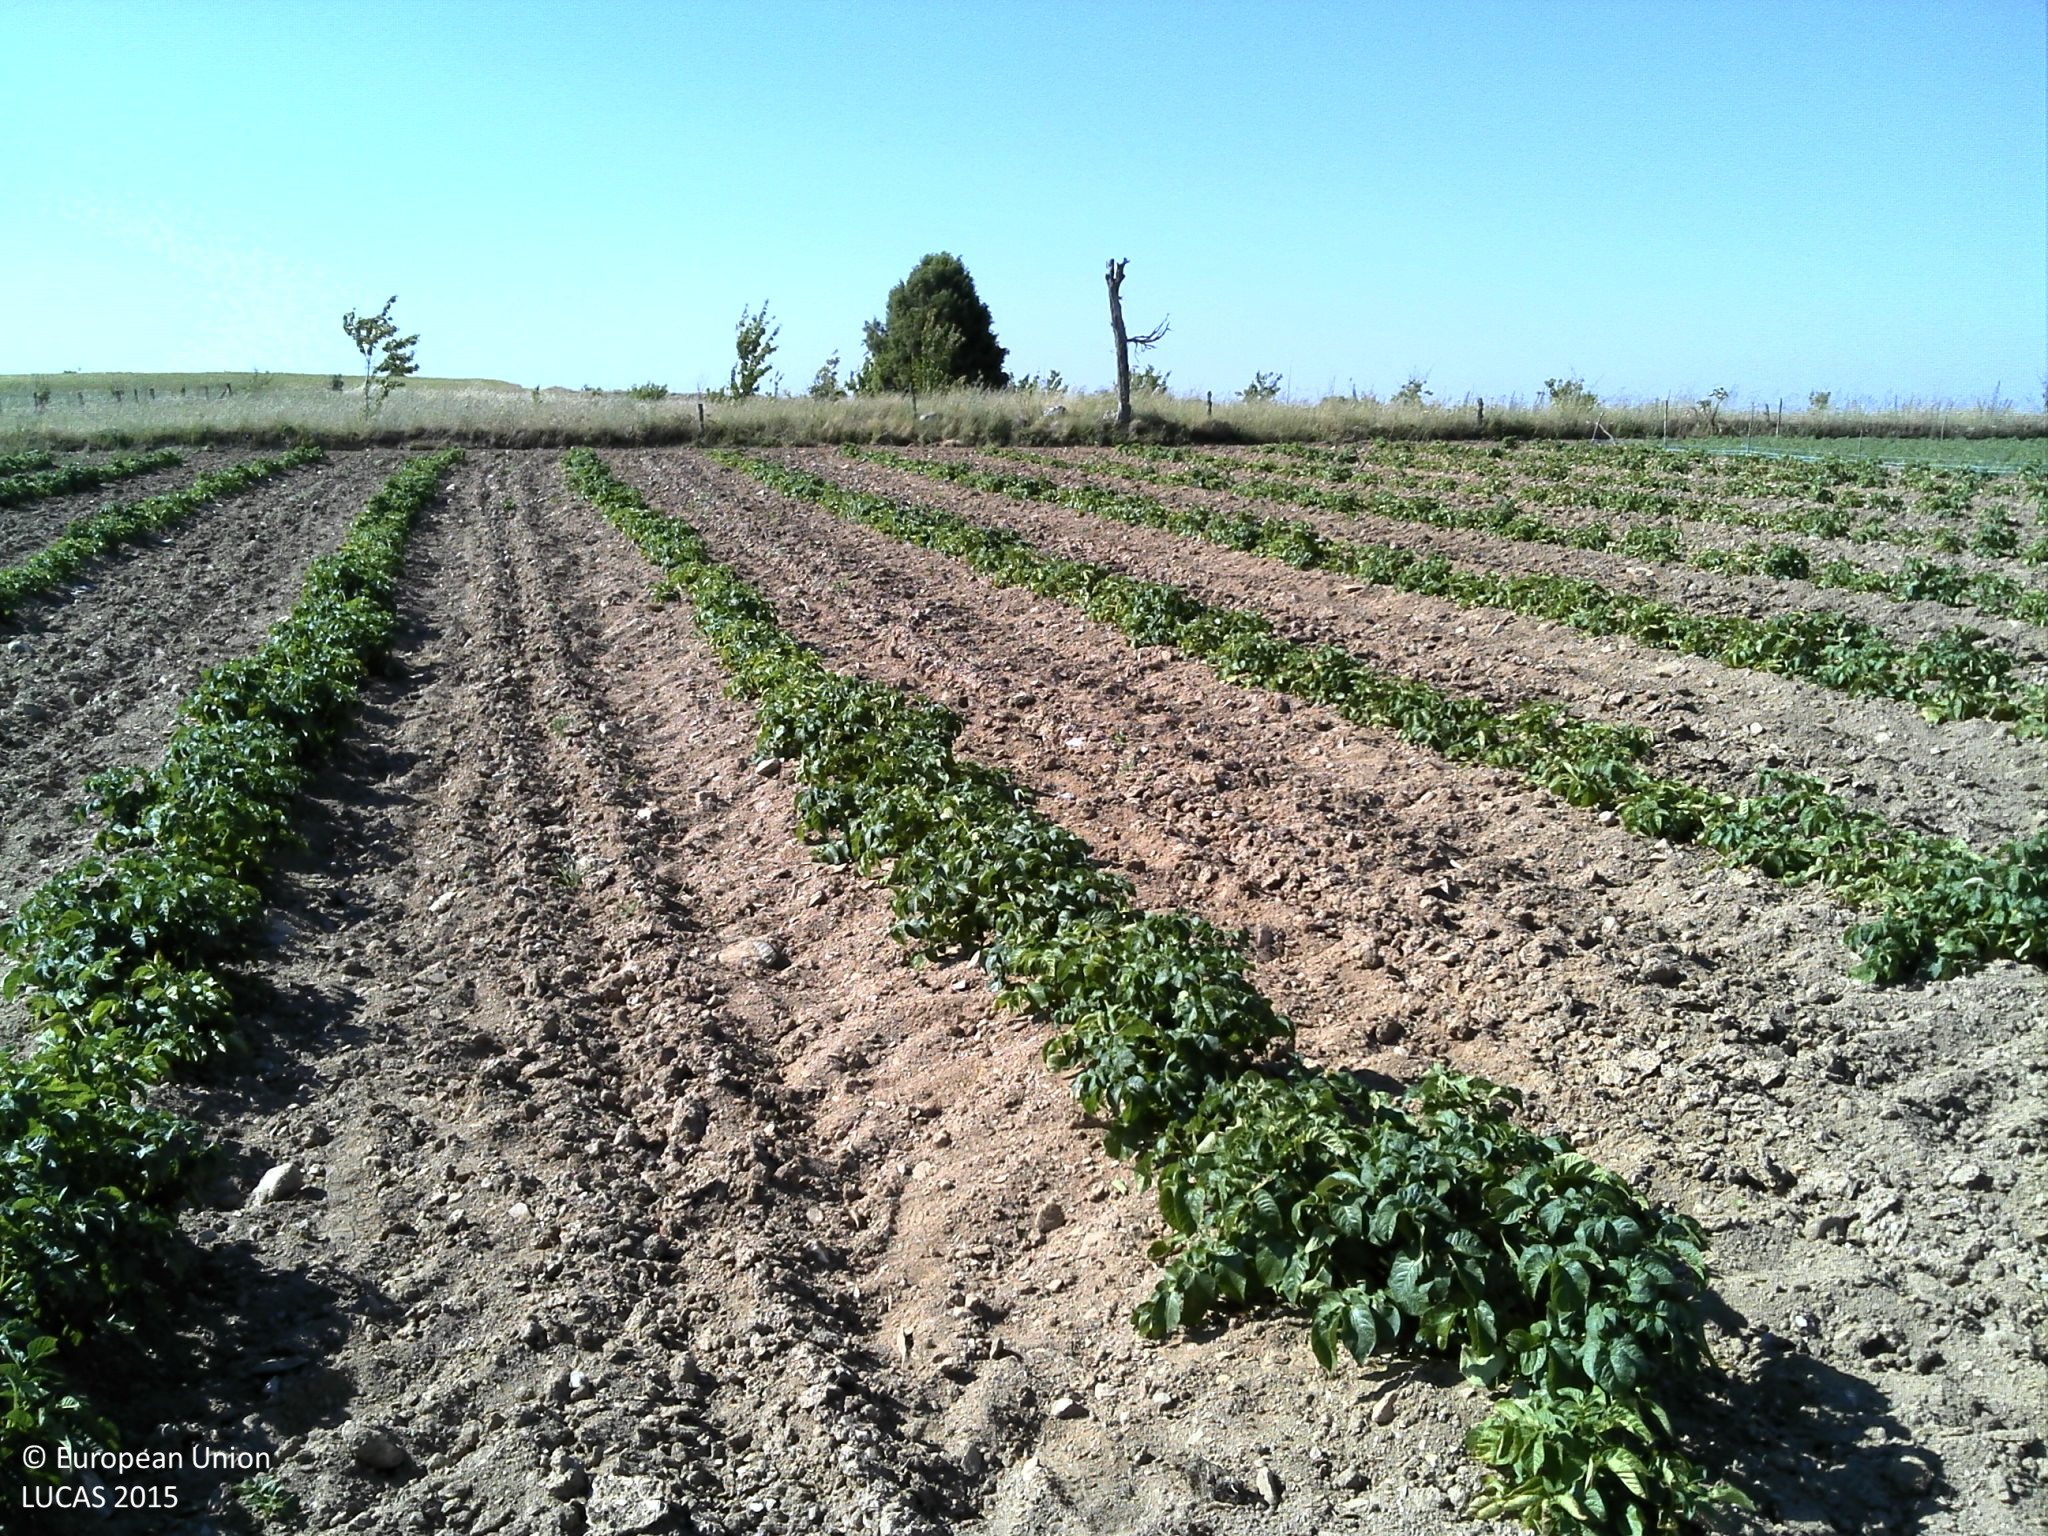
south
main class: Cropland
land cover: Potatoes
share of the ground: < 10 %
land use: Agriculture (excluding fallow land and kitchen gardens)
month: May
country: PT
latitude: 41.4667
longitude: -6.3221
